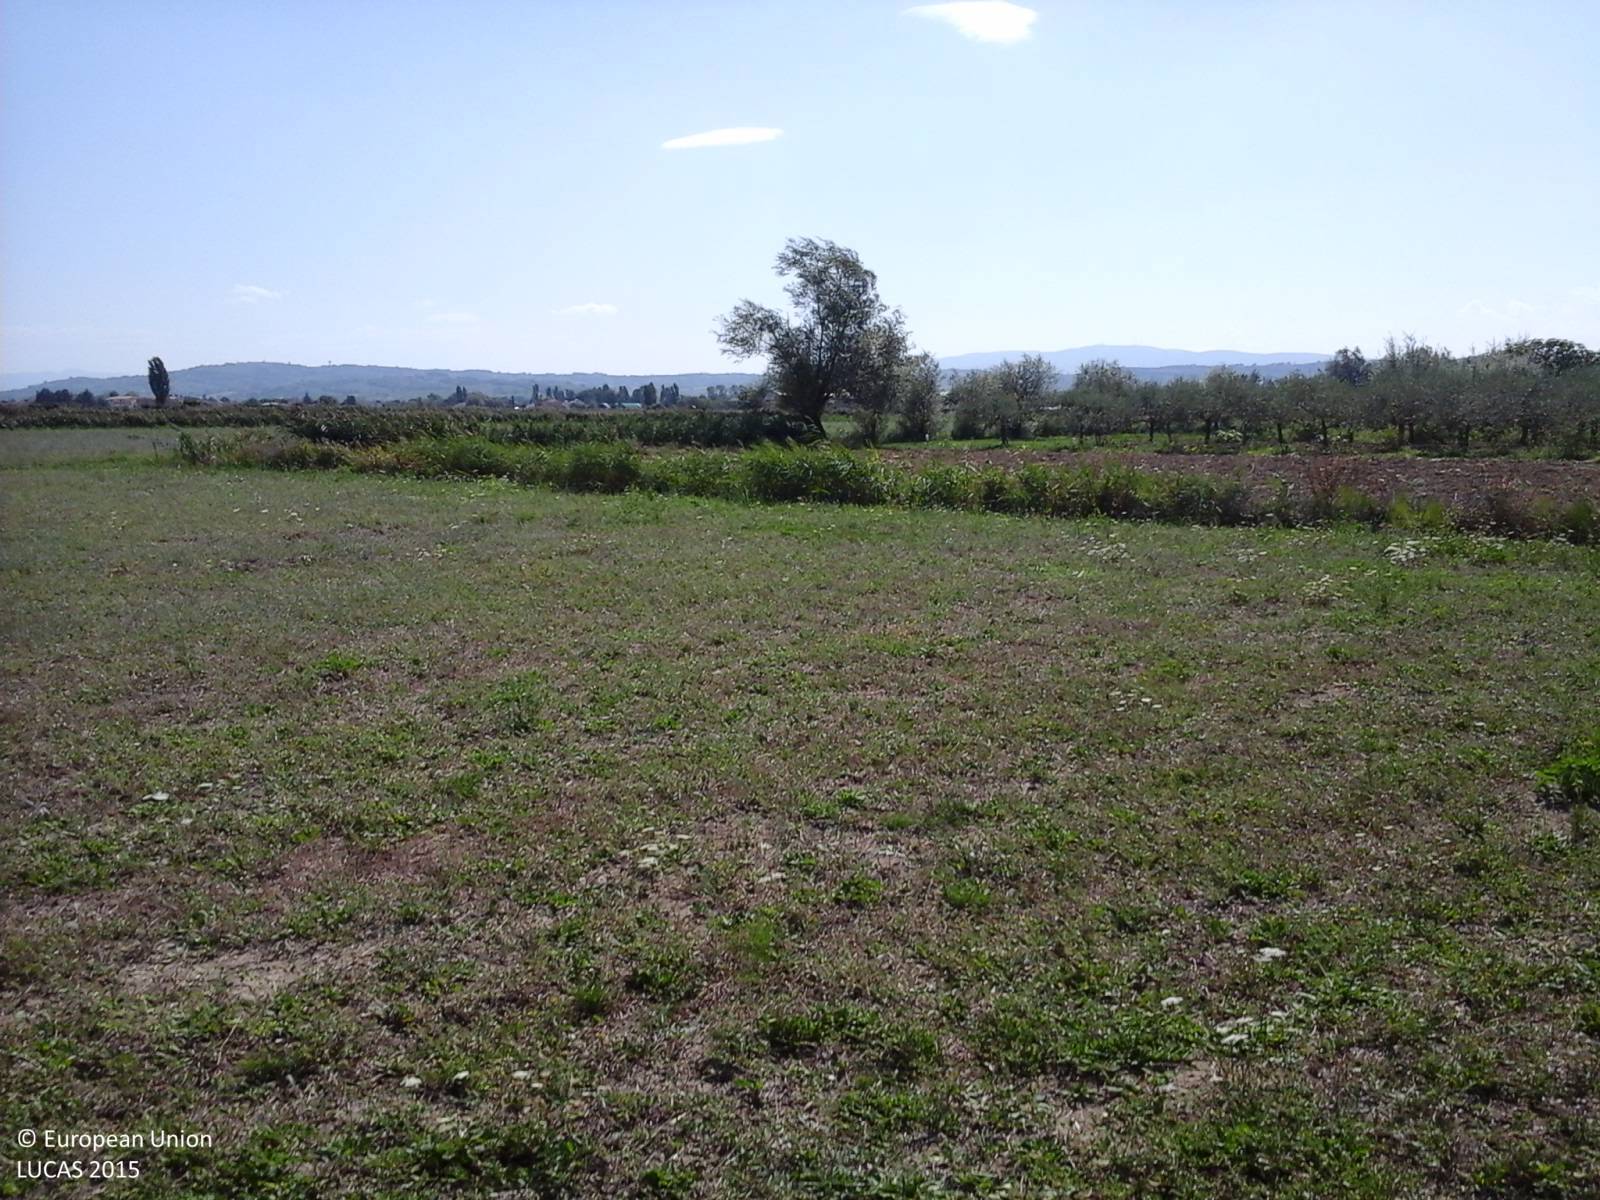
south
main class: Grassland
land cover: Spontaneously vegetated surfaces
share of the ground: 50 - 75 %
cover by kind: herbaceous plants 100 %
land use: Fallow land
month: September
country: IT
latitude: 42.9632
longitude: 12.6280
